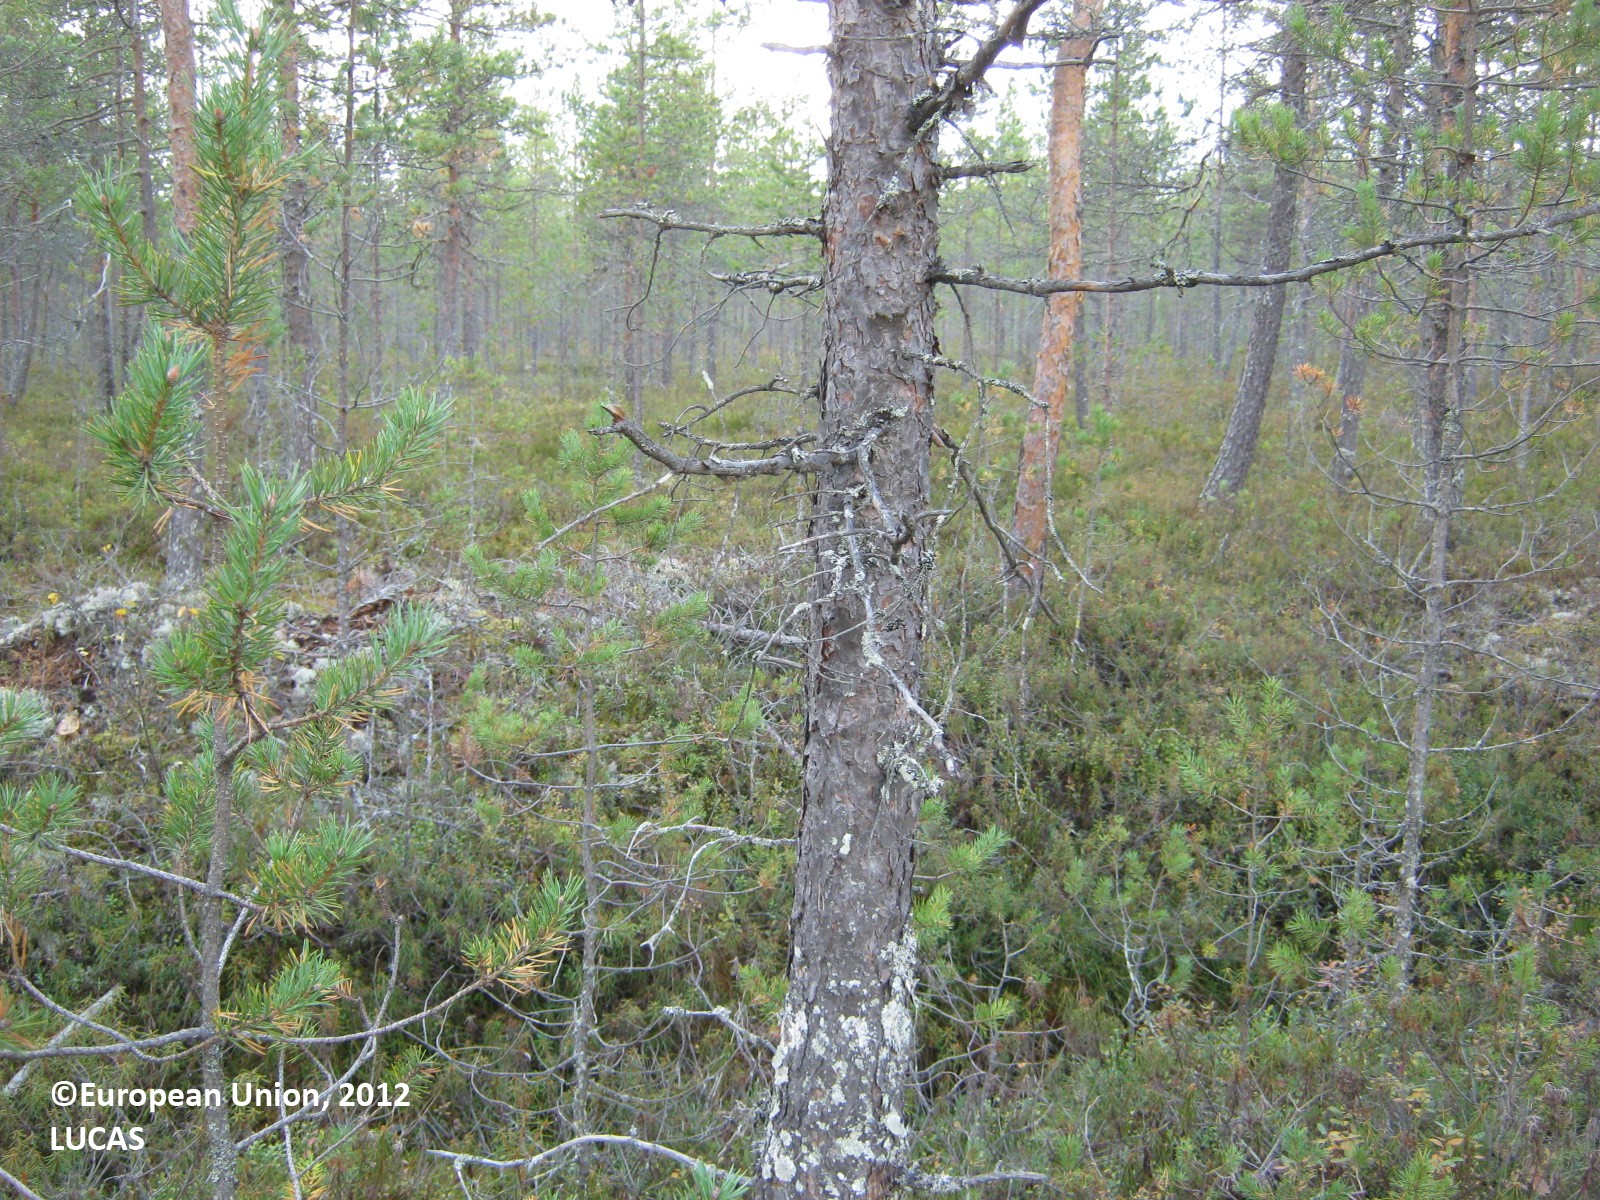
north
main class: Woodland
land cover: Pine dominated coniferous woodland
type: boreal forest
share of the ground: > 75 %
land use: Forestry
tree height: > 5 m
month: September
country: FI
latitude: 63.4635
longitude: 25.8593
